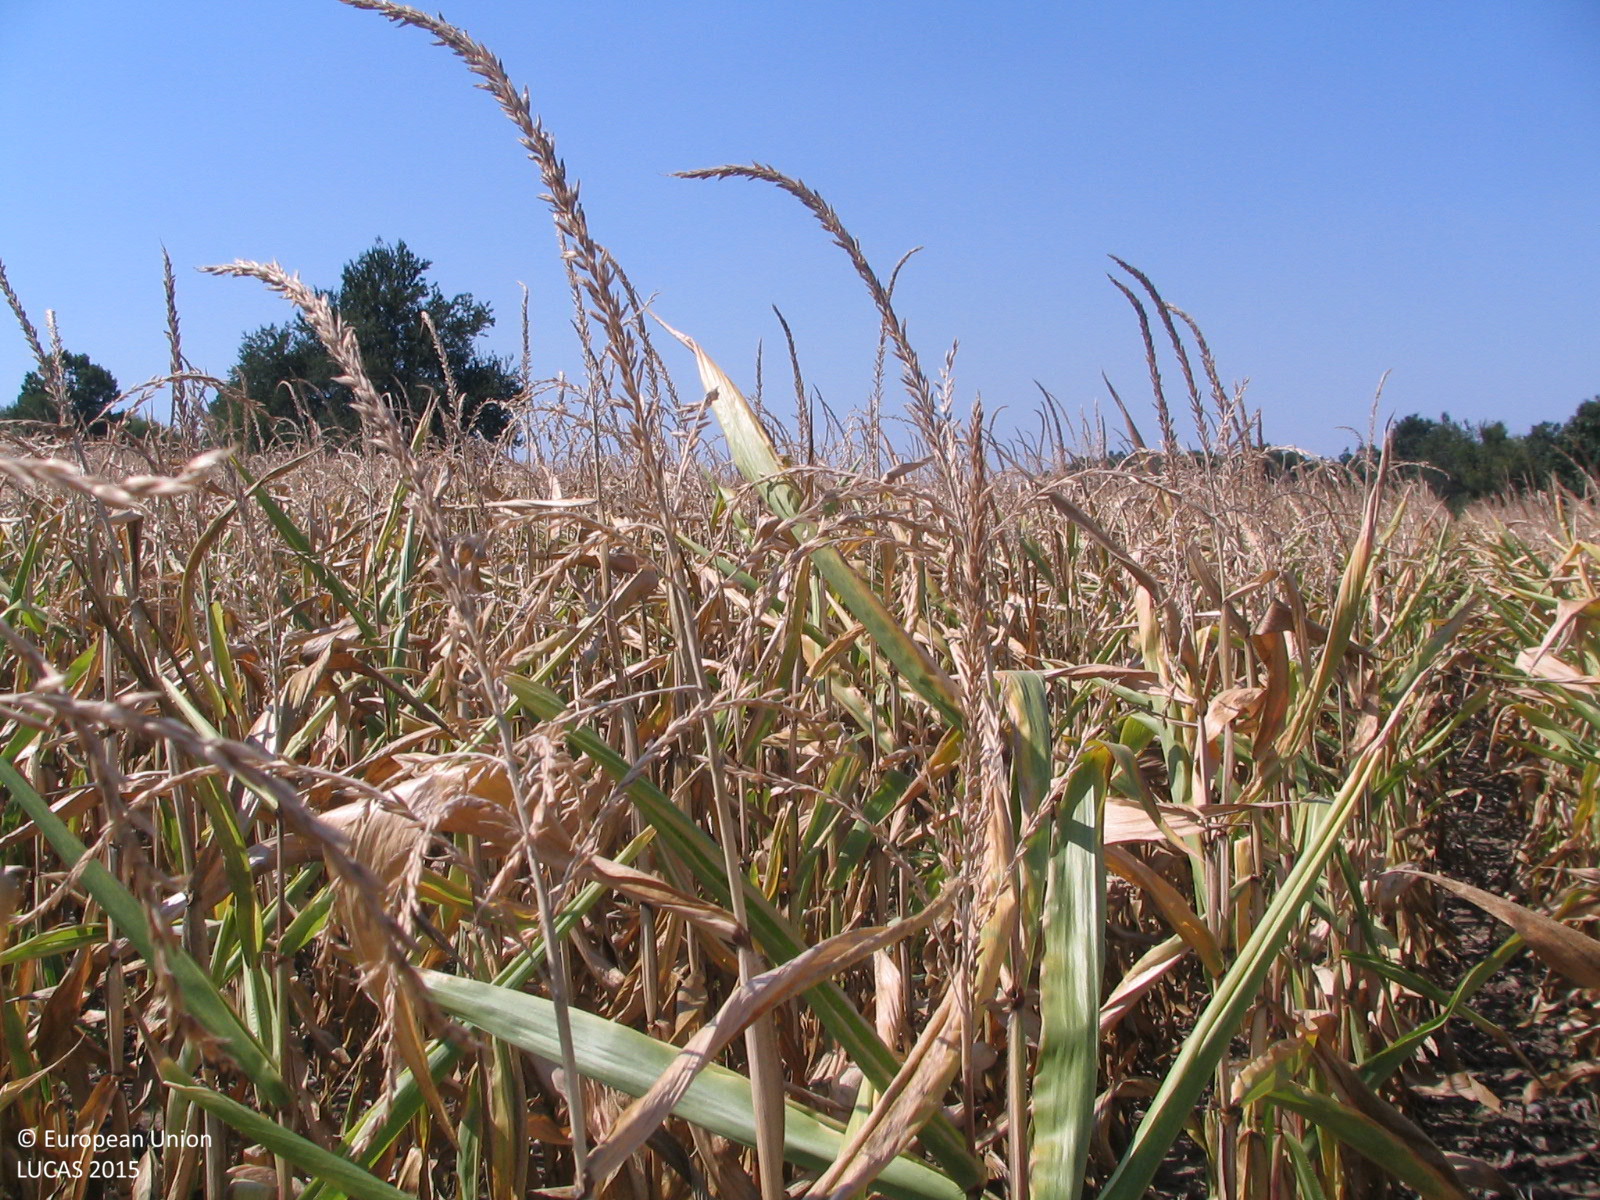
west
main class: Cropland
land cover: Maize
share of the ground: > 75 %
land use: Agriculture (excluding fallow land and kitchen gardens)
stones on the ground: < 10 %
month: August
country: BG
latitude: 43.1878
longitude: 24.4411
